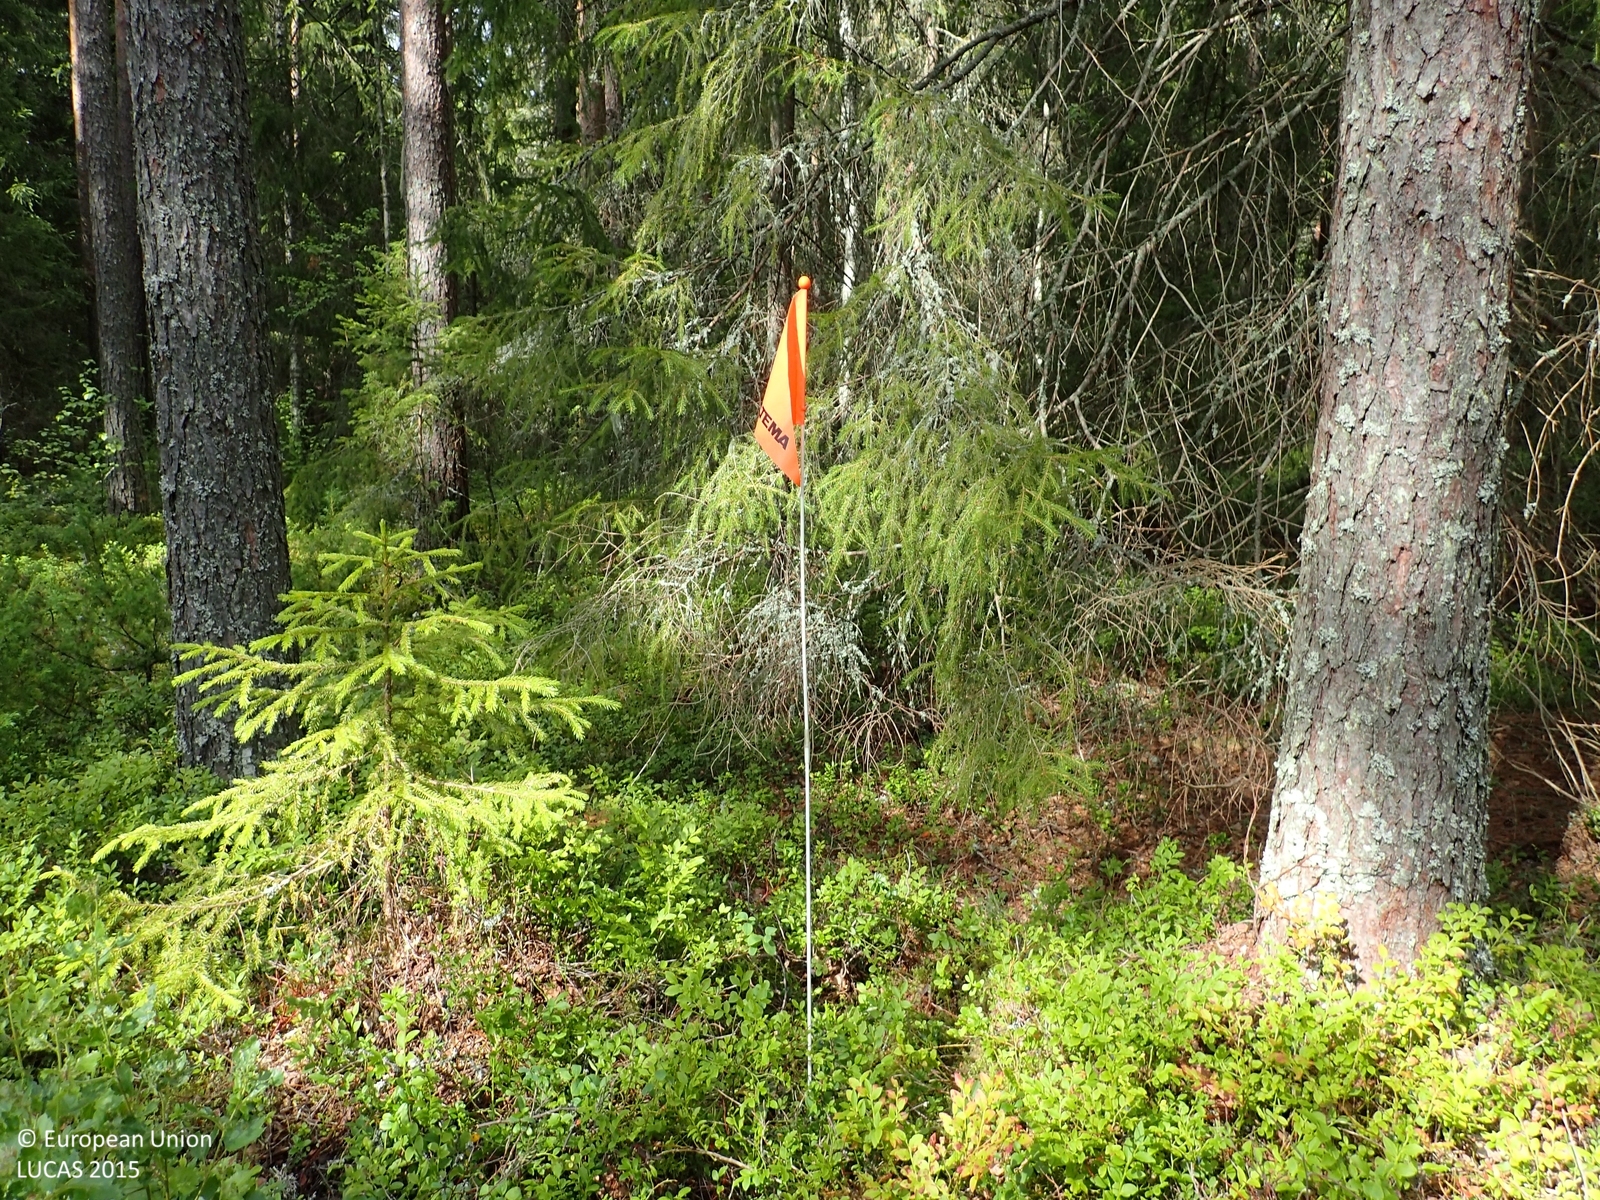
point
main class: Woodland
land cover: Other coniferous woodland
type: boreal forest
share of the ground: > 75 %
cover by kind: coniferous forest trees 70 %, shrubs 20 %, broadleaved forest trees 10 %
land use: Forestry
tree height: > 5 m
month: August
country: FI
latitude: 62.6364
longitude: 21.8447
